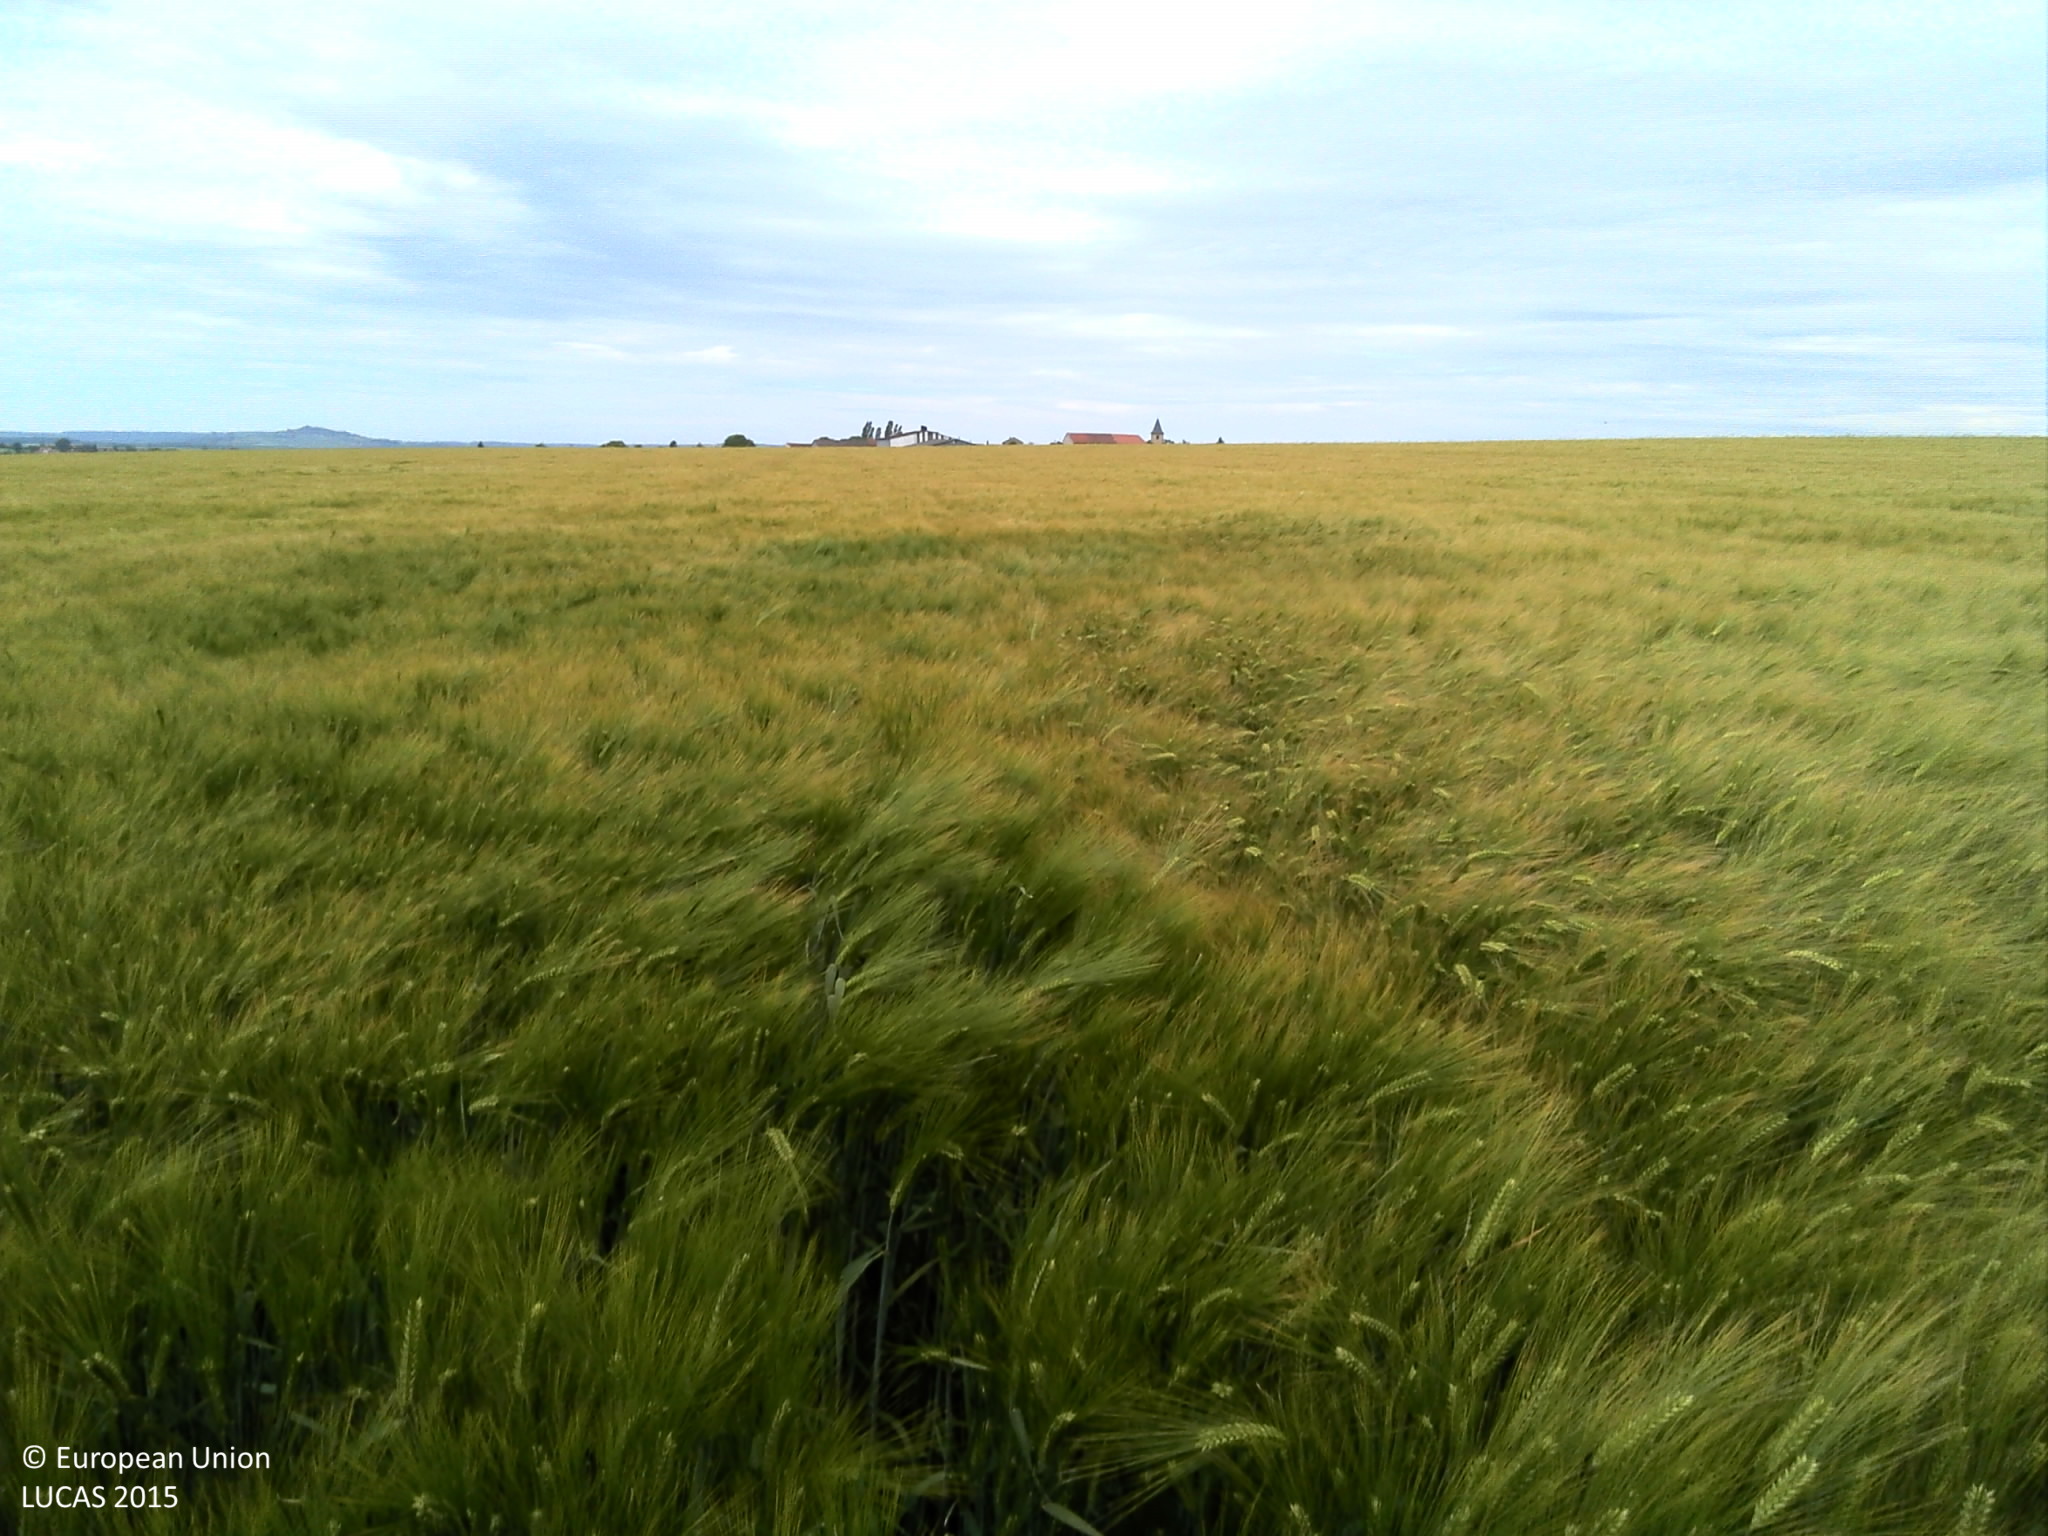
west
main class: Cropland
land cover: Barley
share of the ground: > 75 %
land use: Agriculture (excluding fallow land and kitchen gardens)
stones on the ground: < 10 %
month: June
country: FR
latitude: 48.9521
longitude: 6.2446
